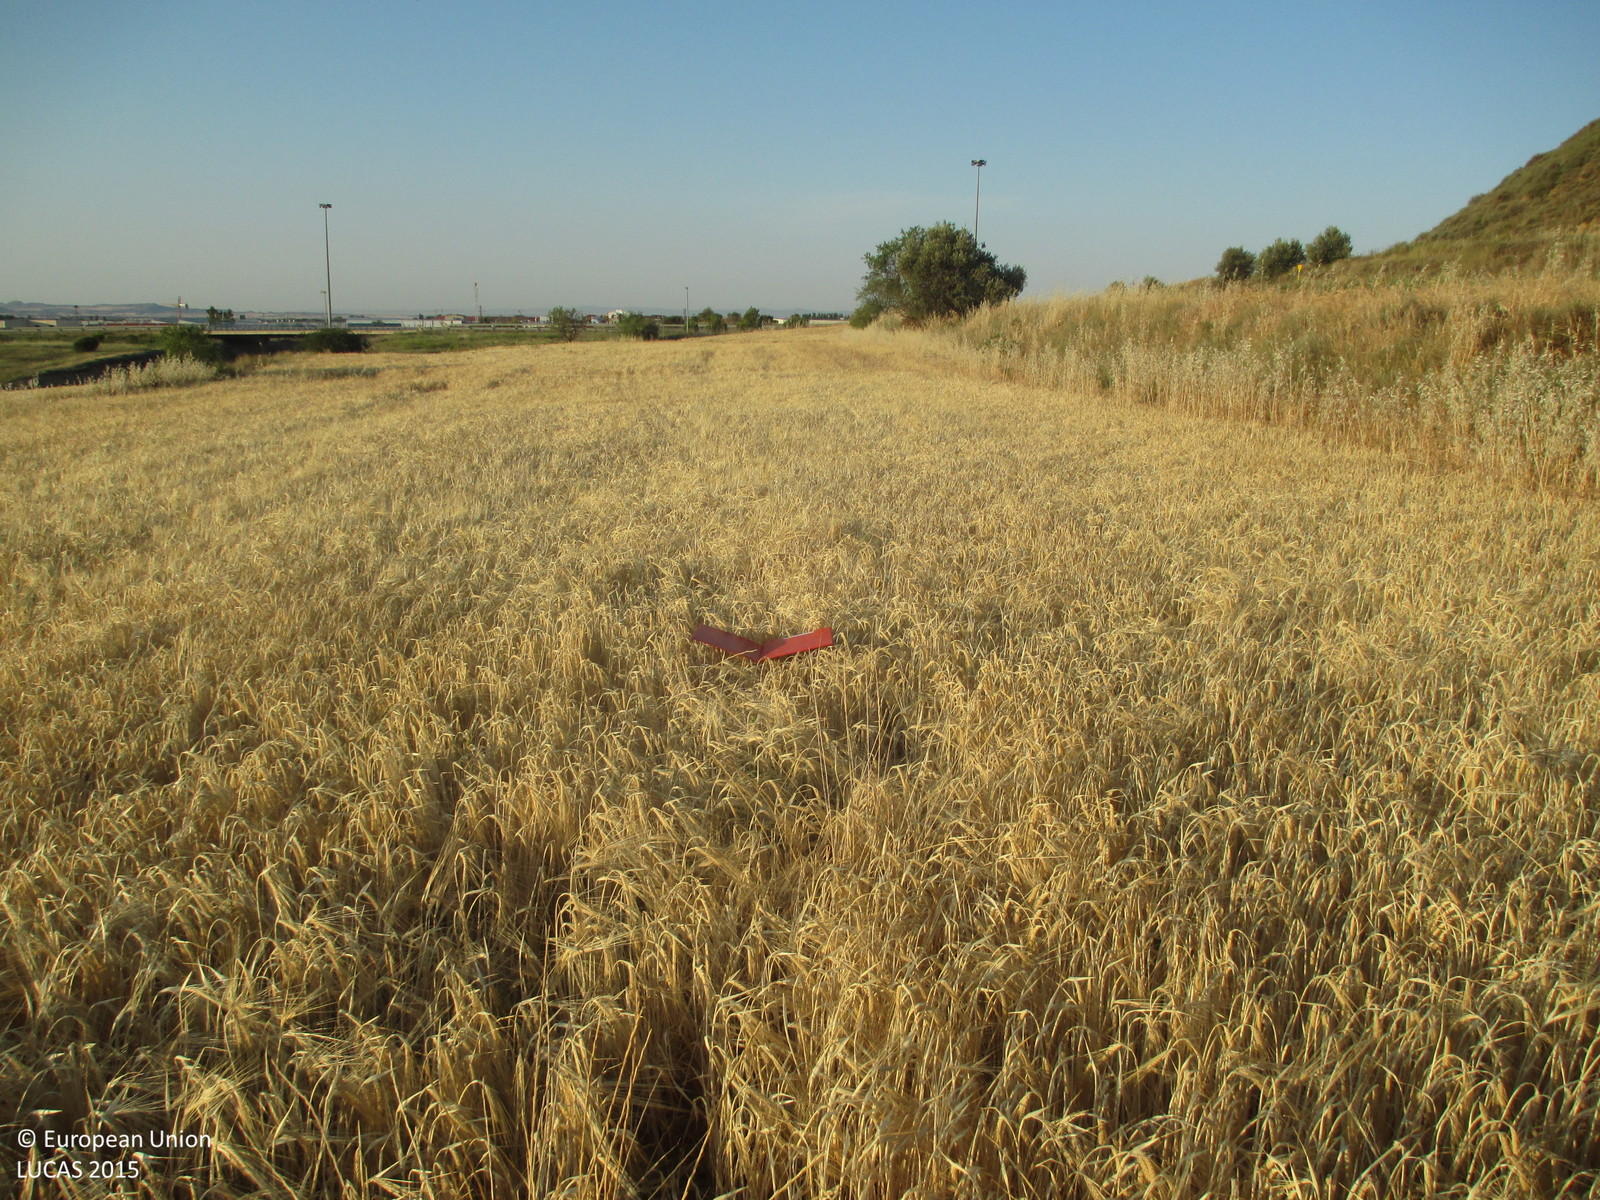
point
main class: Cropland
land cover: Barley
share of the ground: > 75 %
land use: Agriculture (excluding fallow land and kitchen gardens)
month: June
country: ES
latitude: 42.1542
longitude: -0.3941
